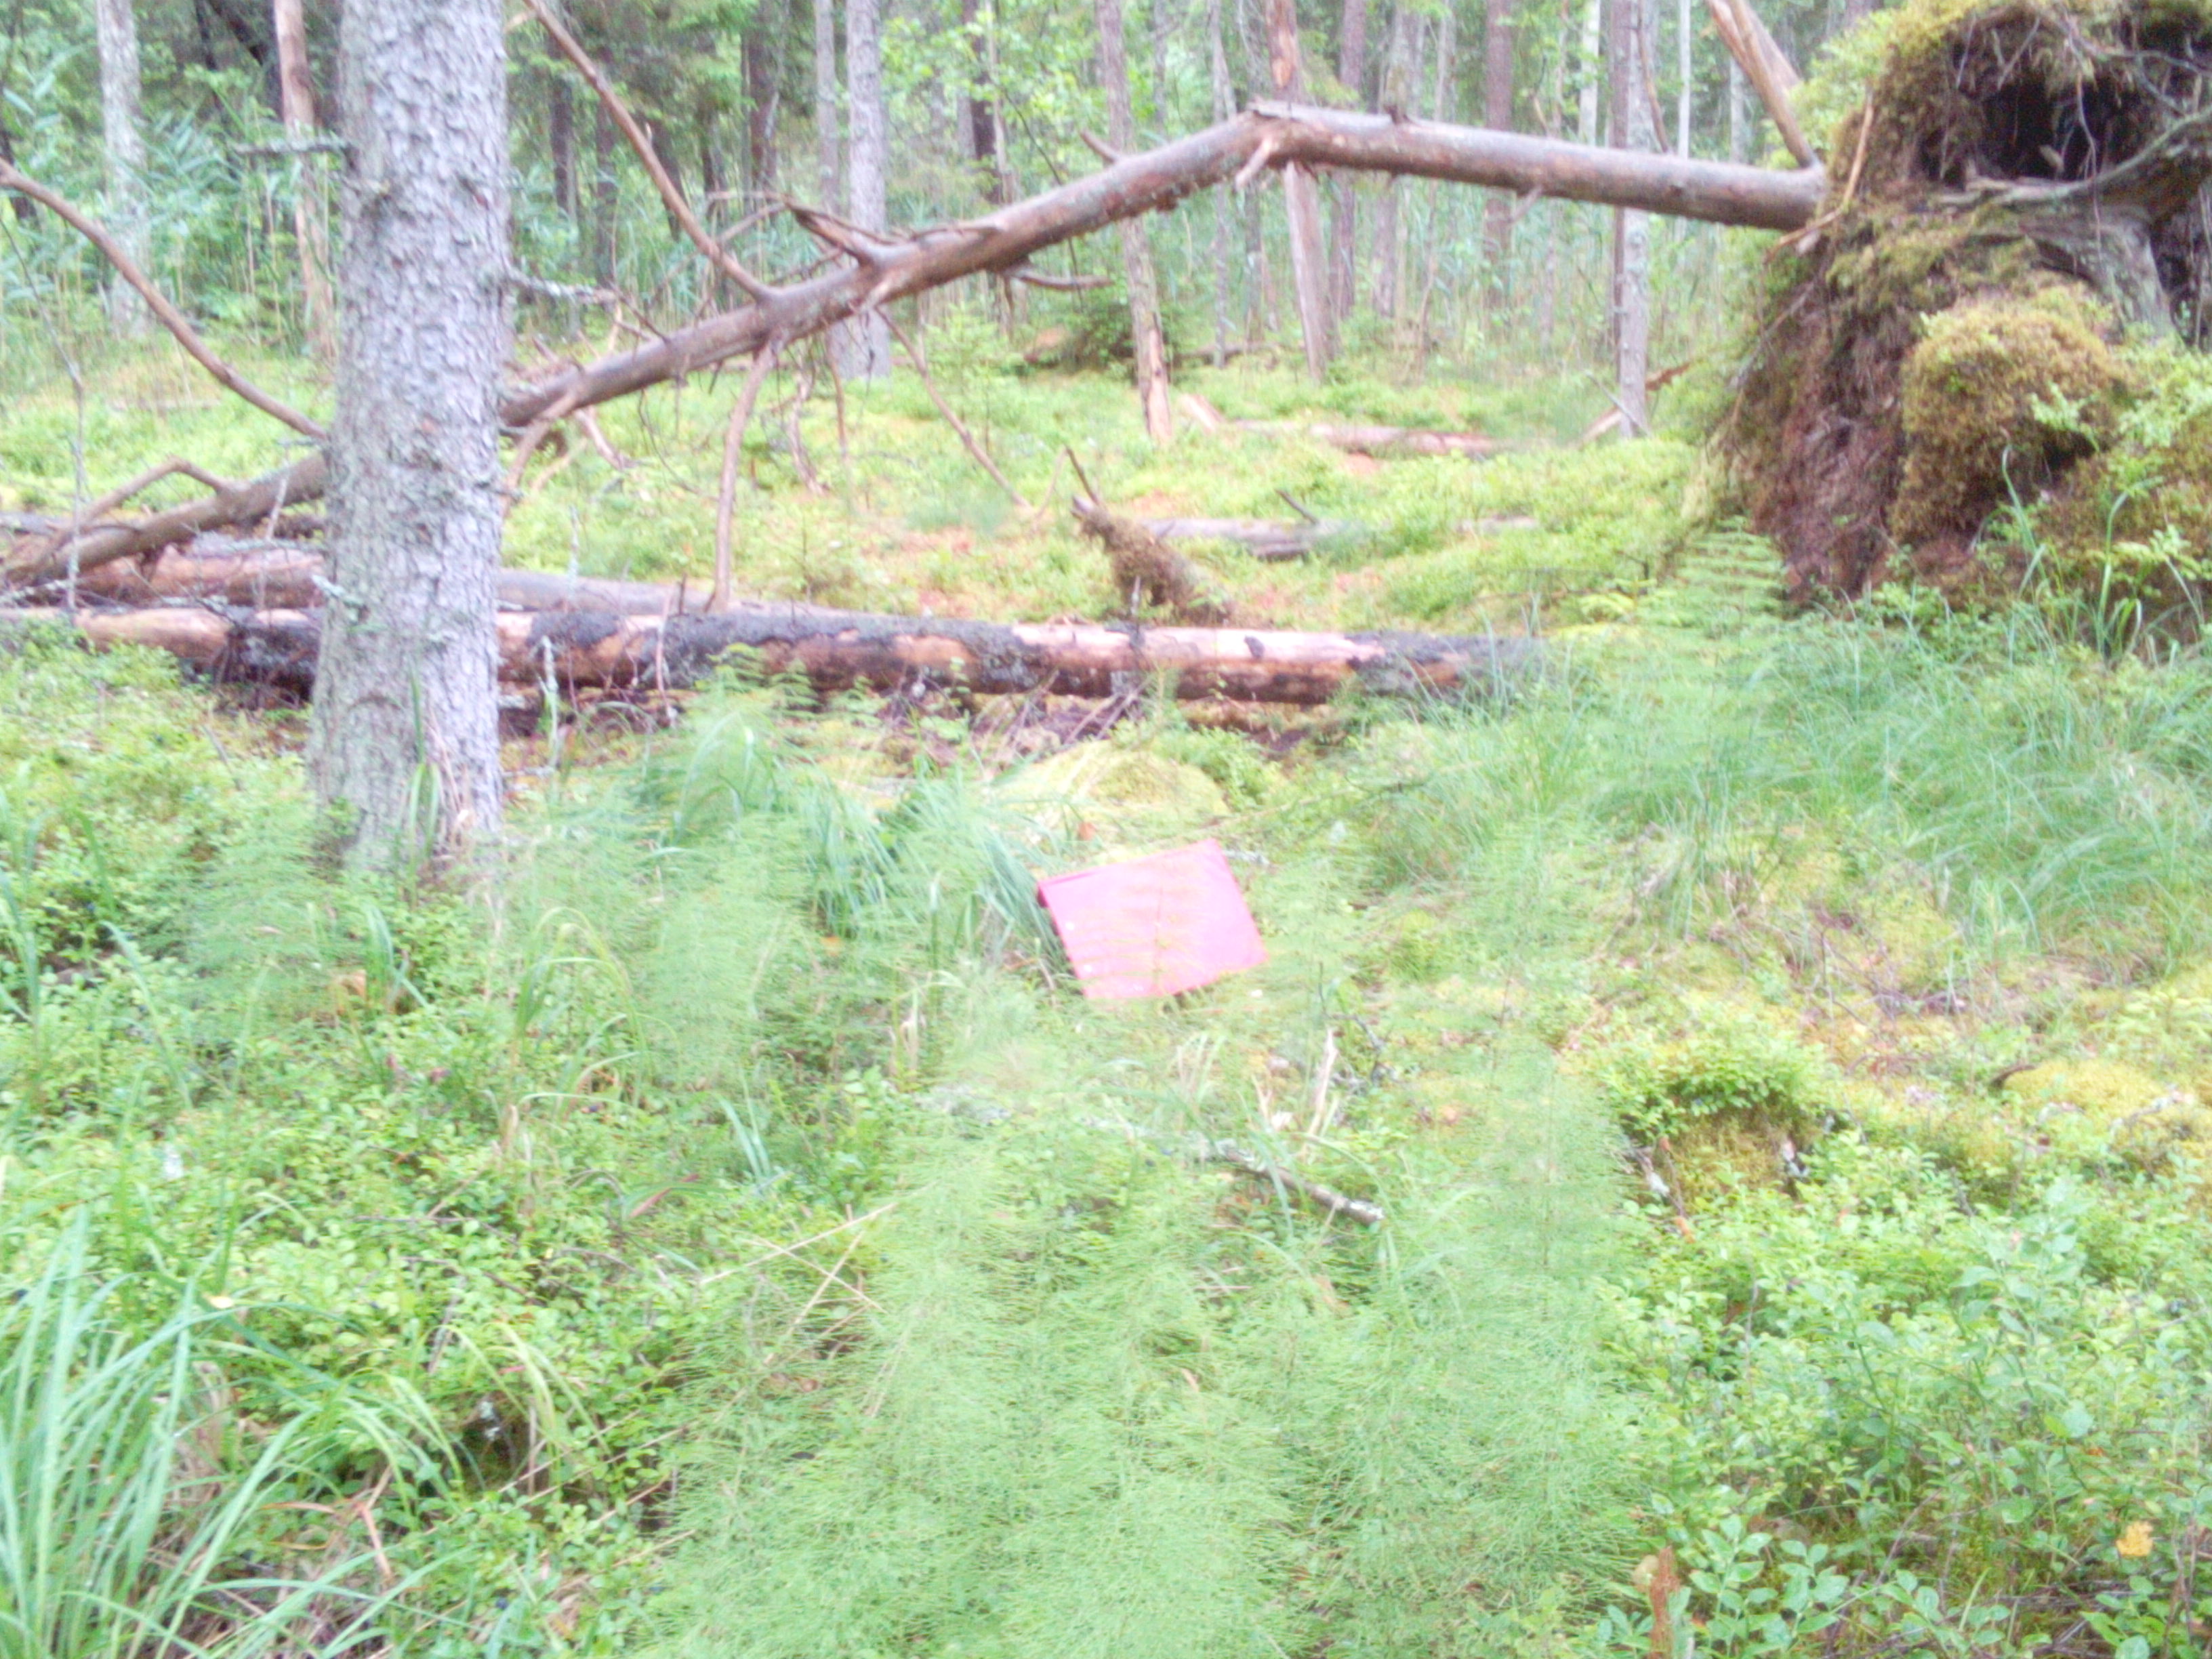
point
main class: Woodland
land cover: Other coniferous woodland
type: hemiboreal forest and nemoral coniferous forest and mixed broadleaved-coniferous forest
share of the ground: > 75 %
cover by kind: coniferous forest trees 75 %, broadleaved forest trees 10 %, lichens and mosses 10 %, herbaceous plants 5 %
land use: Forestry
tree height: > 5 m
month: July
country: LV
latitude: 57.0187
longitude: 22.0554
